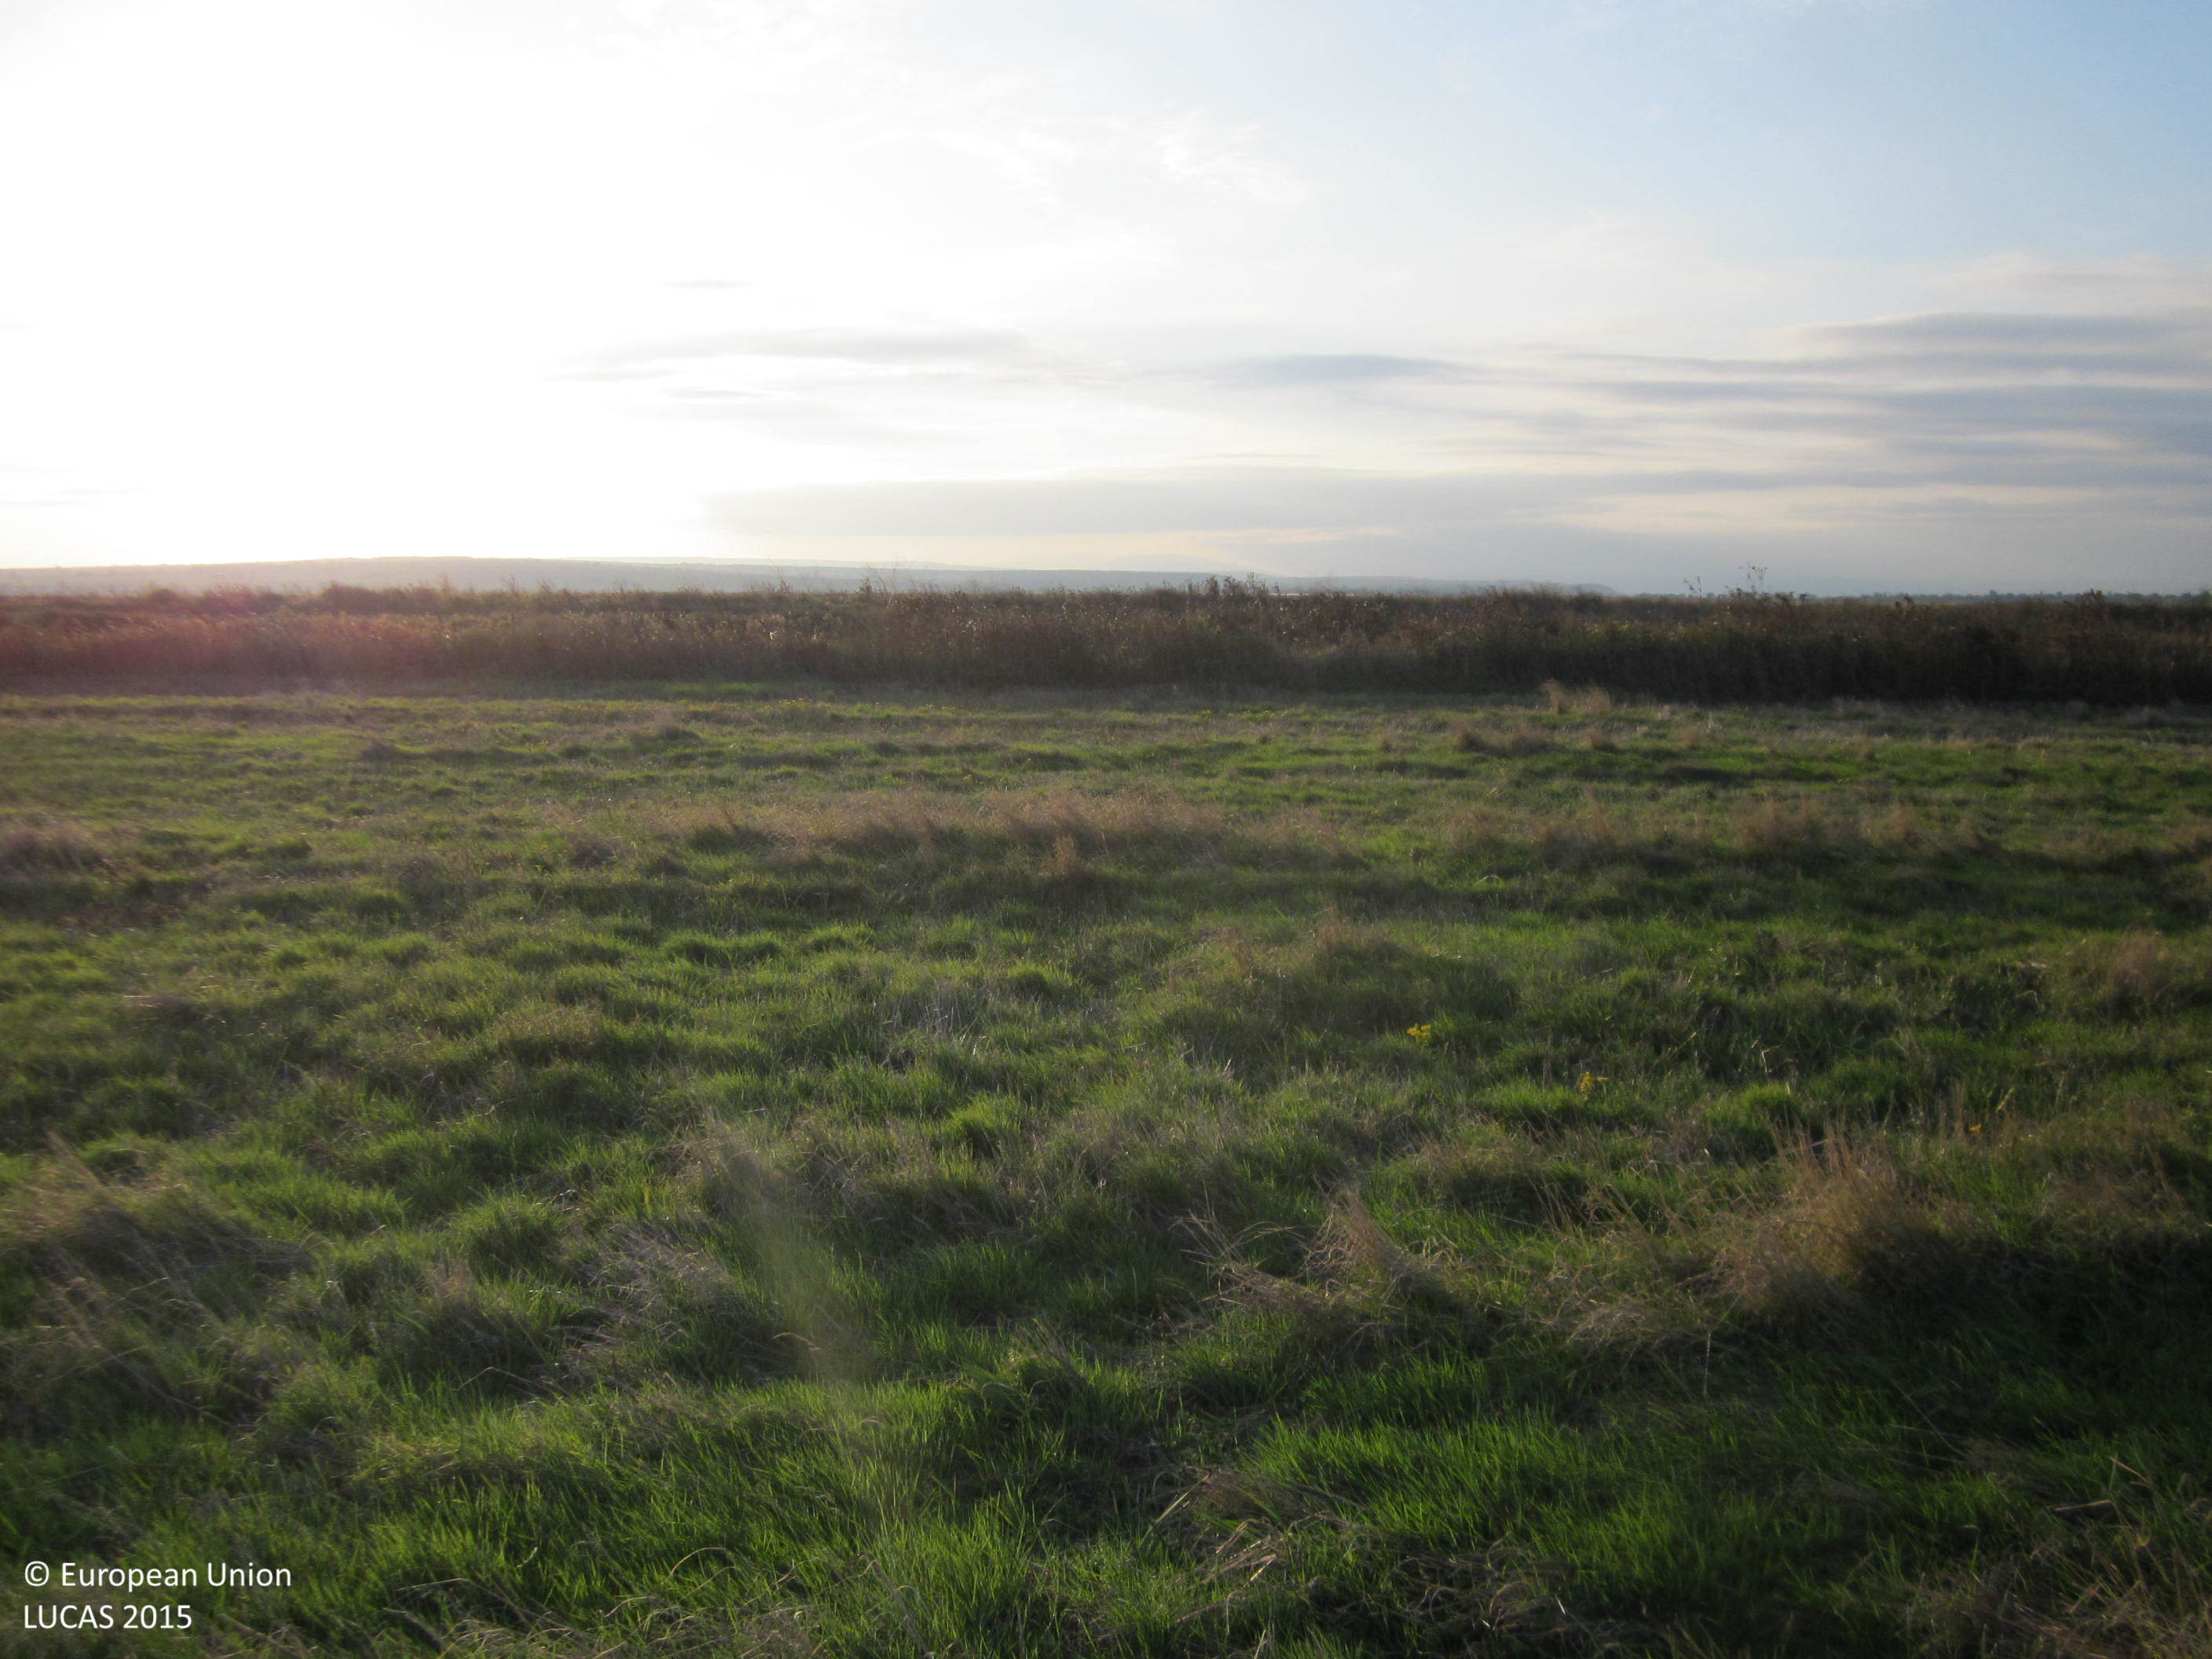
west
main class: Grassland
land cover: Grassland without tree/shrub cover
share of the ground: > 75 %
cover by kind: herbaceous plants 100 %
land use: Agriculture (excluding fallow land and kitchen gardens)
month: October
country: BG
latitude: 42.6883
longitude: 26.9365
